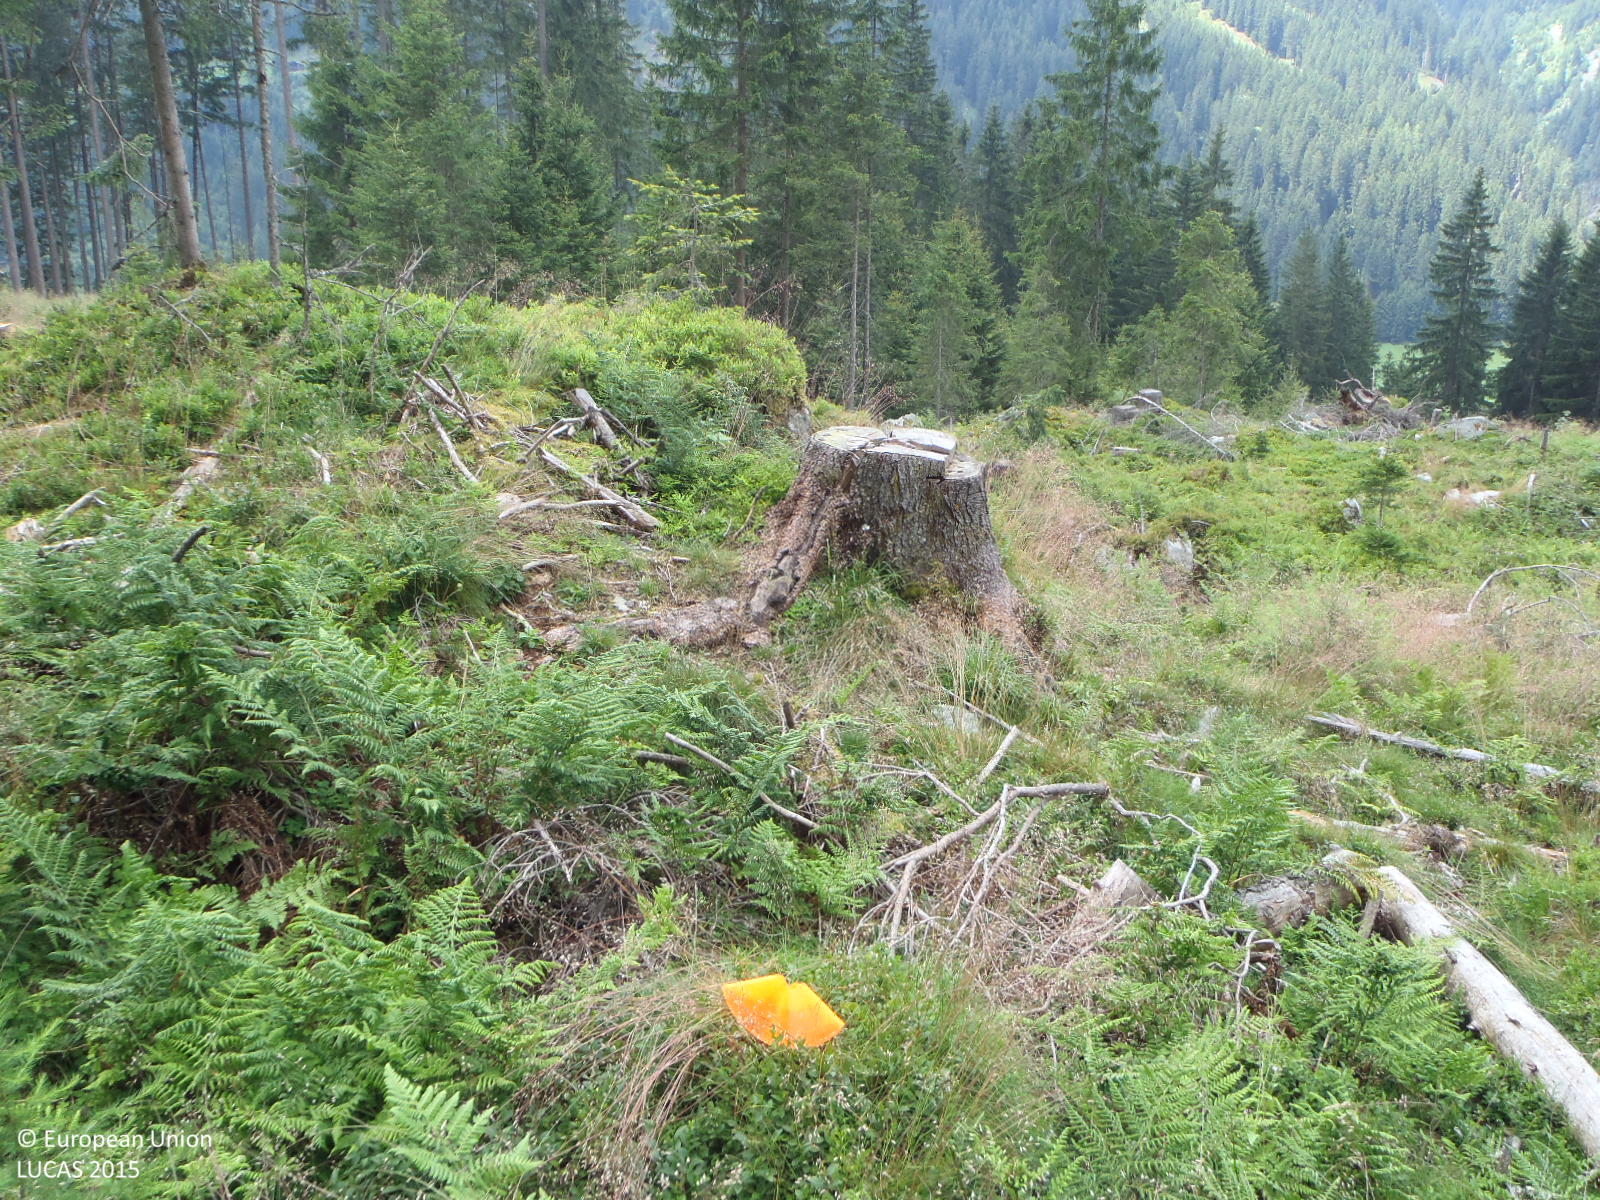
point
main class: Woodland
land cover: Spruce dominated coniferous woodland
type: alpine coniferous forest
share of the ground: 10 - 25 %
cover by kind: herbaceous plants 70 %, coniferous forest trees 25 %, shrubs 5 %
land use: Forestry
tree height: < 5 m
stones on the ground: < 10 %
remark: Clear cut
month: July
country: AT
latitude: 47.1478
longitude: 11.7260
